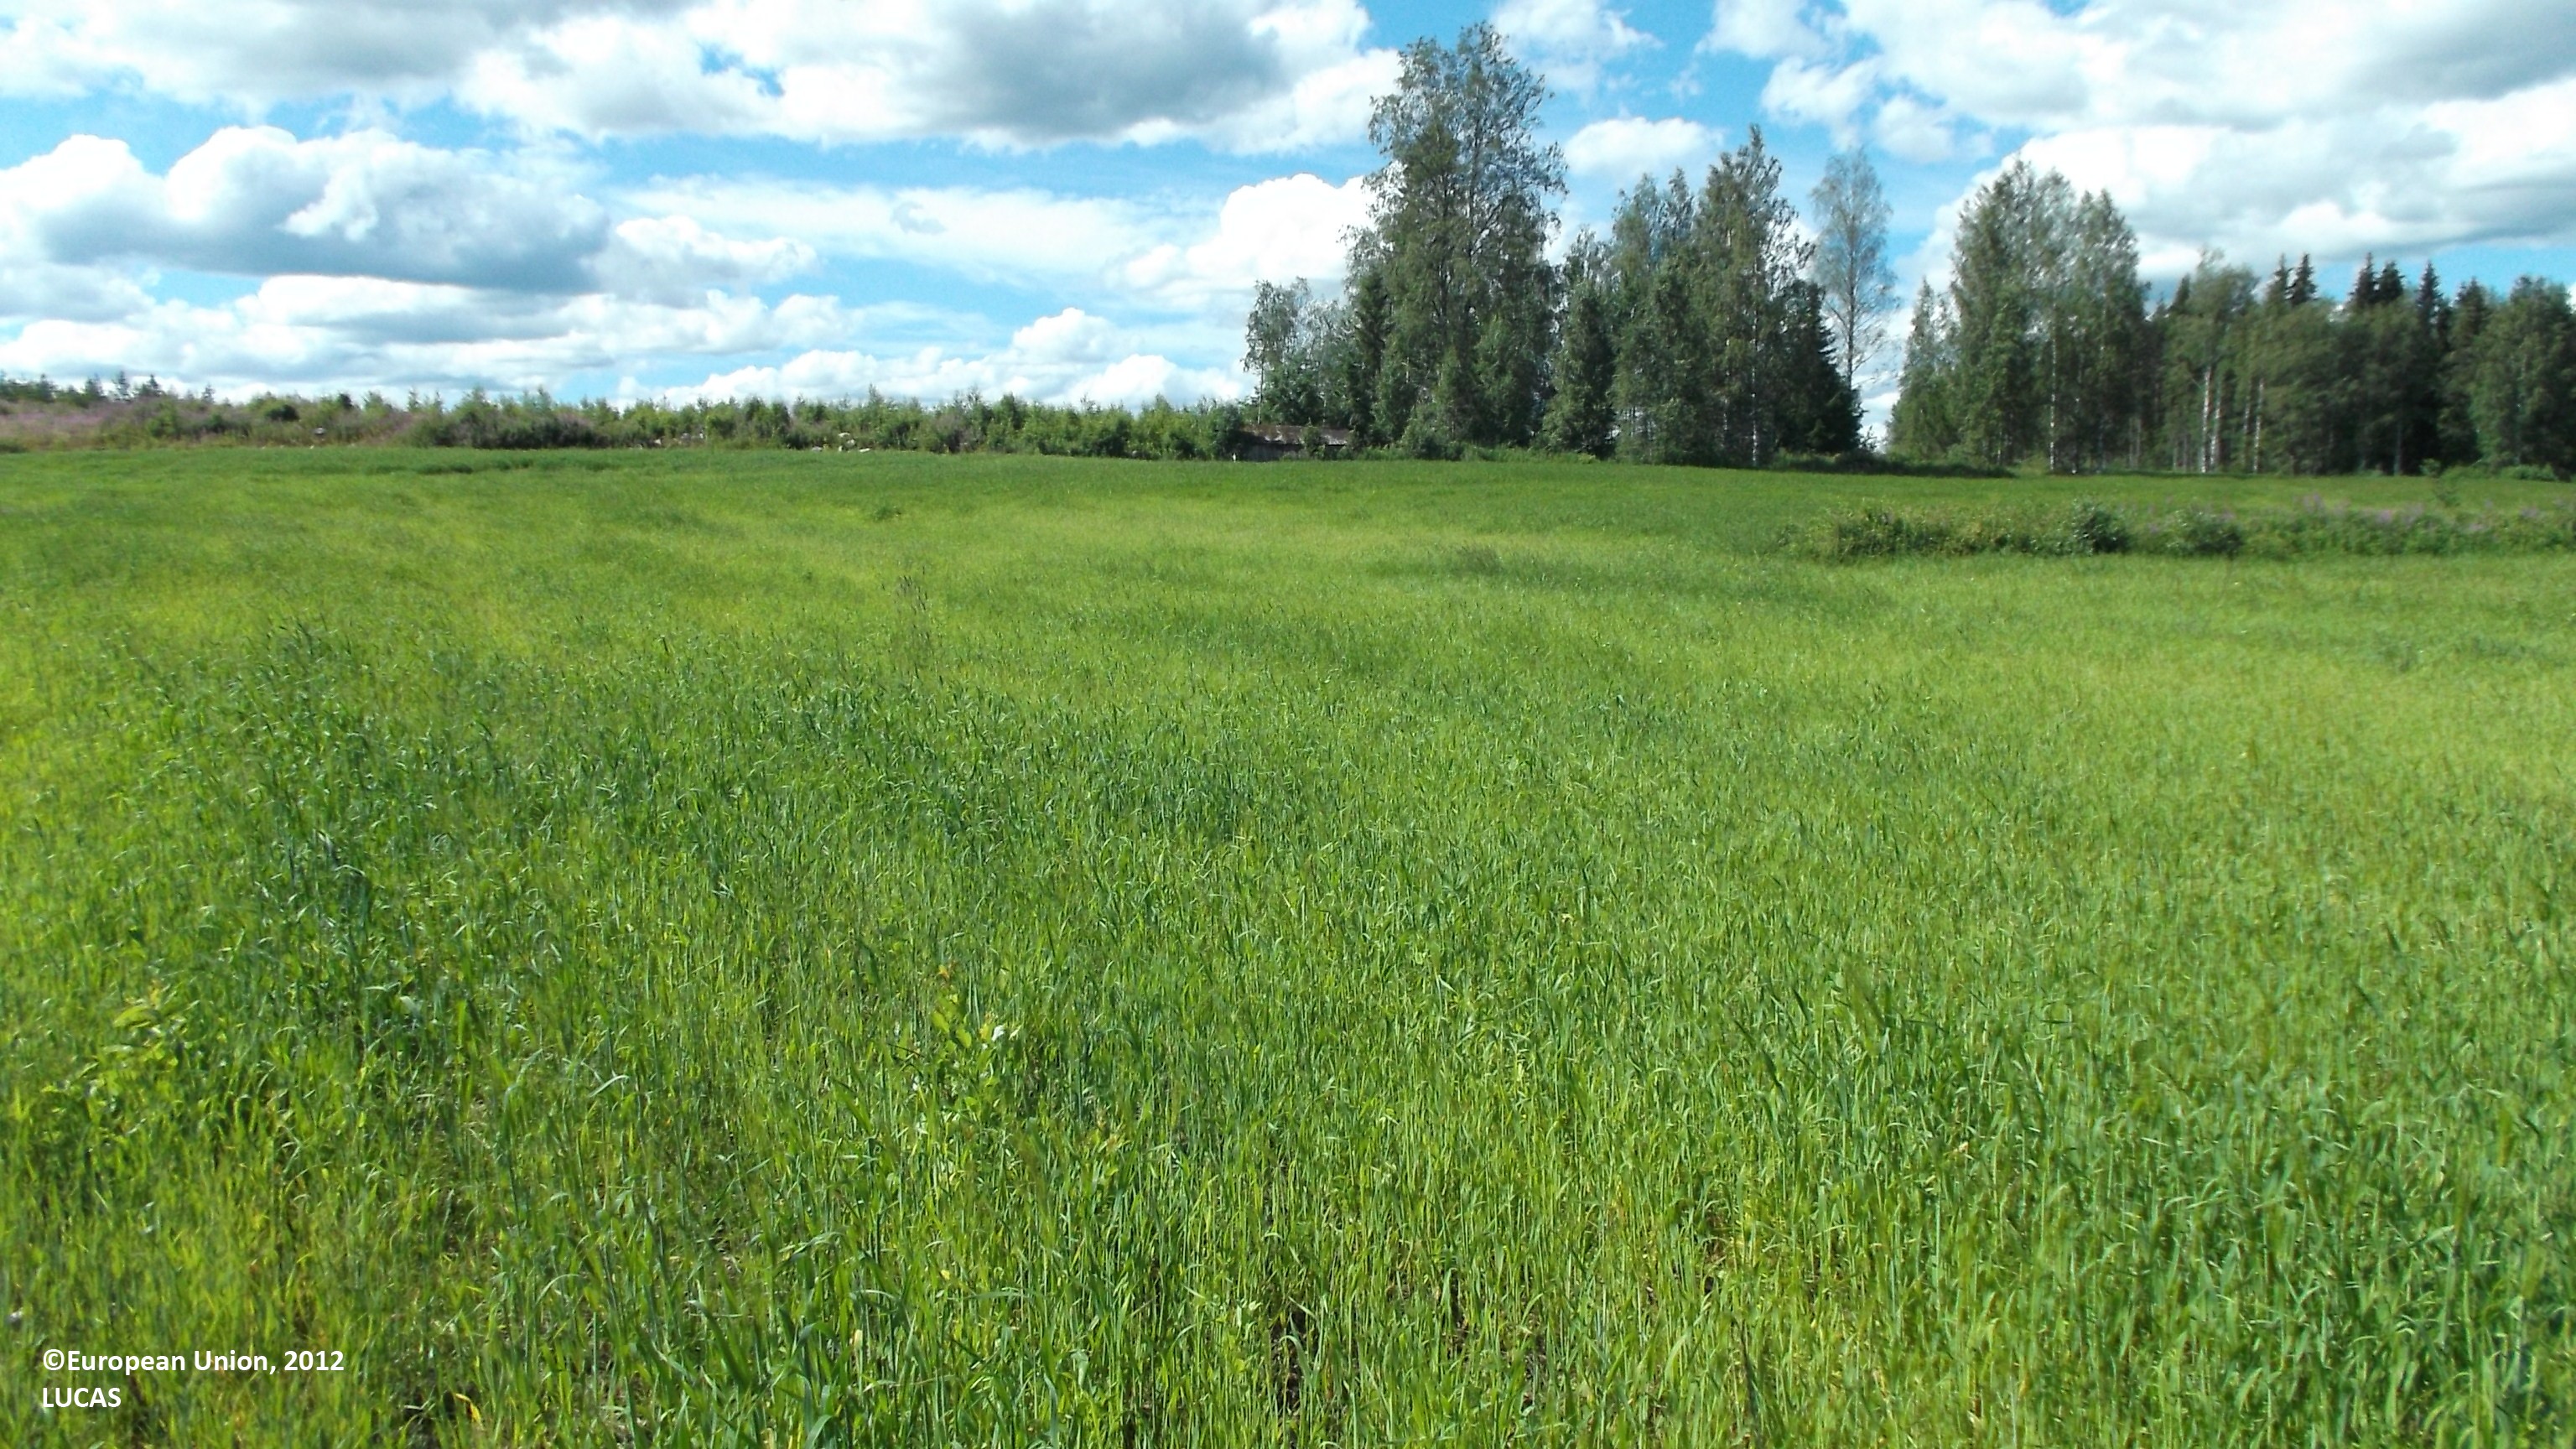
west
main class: Grassland
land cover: Grassland without tree/shrub cover
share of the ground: 25 - 50 %
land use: Fallow land
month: July
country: FI
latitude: 63.3259
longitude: 23.8667
